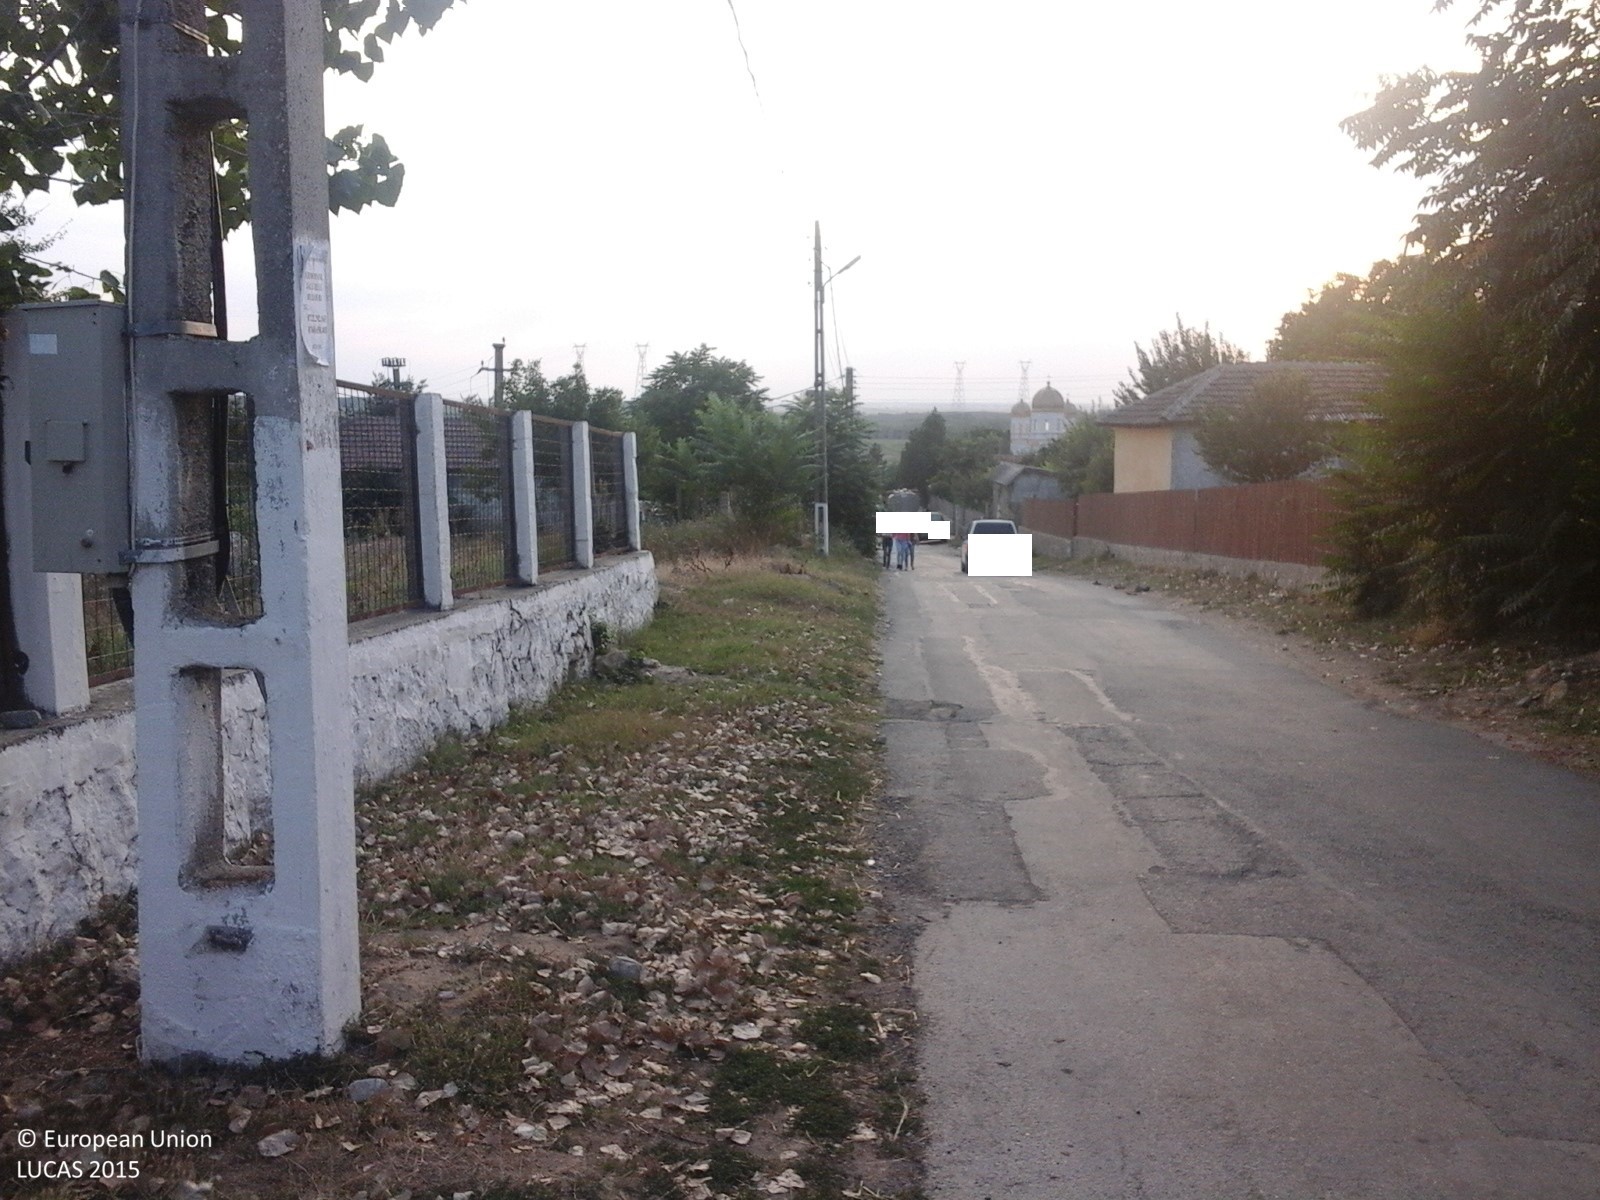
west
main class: Grassland
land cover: Grassland with sparse tree/shrub cover
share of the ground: > 75 %
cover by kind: herbaceous plants 85 %, shrubs 10 %, broadleaved forest trees 5 %
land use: Community services
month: August
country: RO
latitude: 44.3719
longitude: 28.0666
